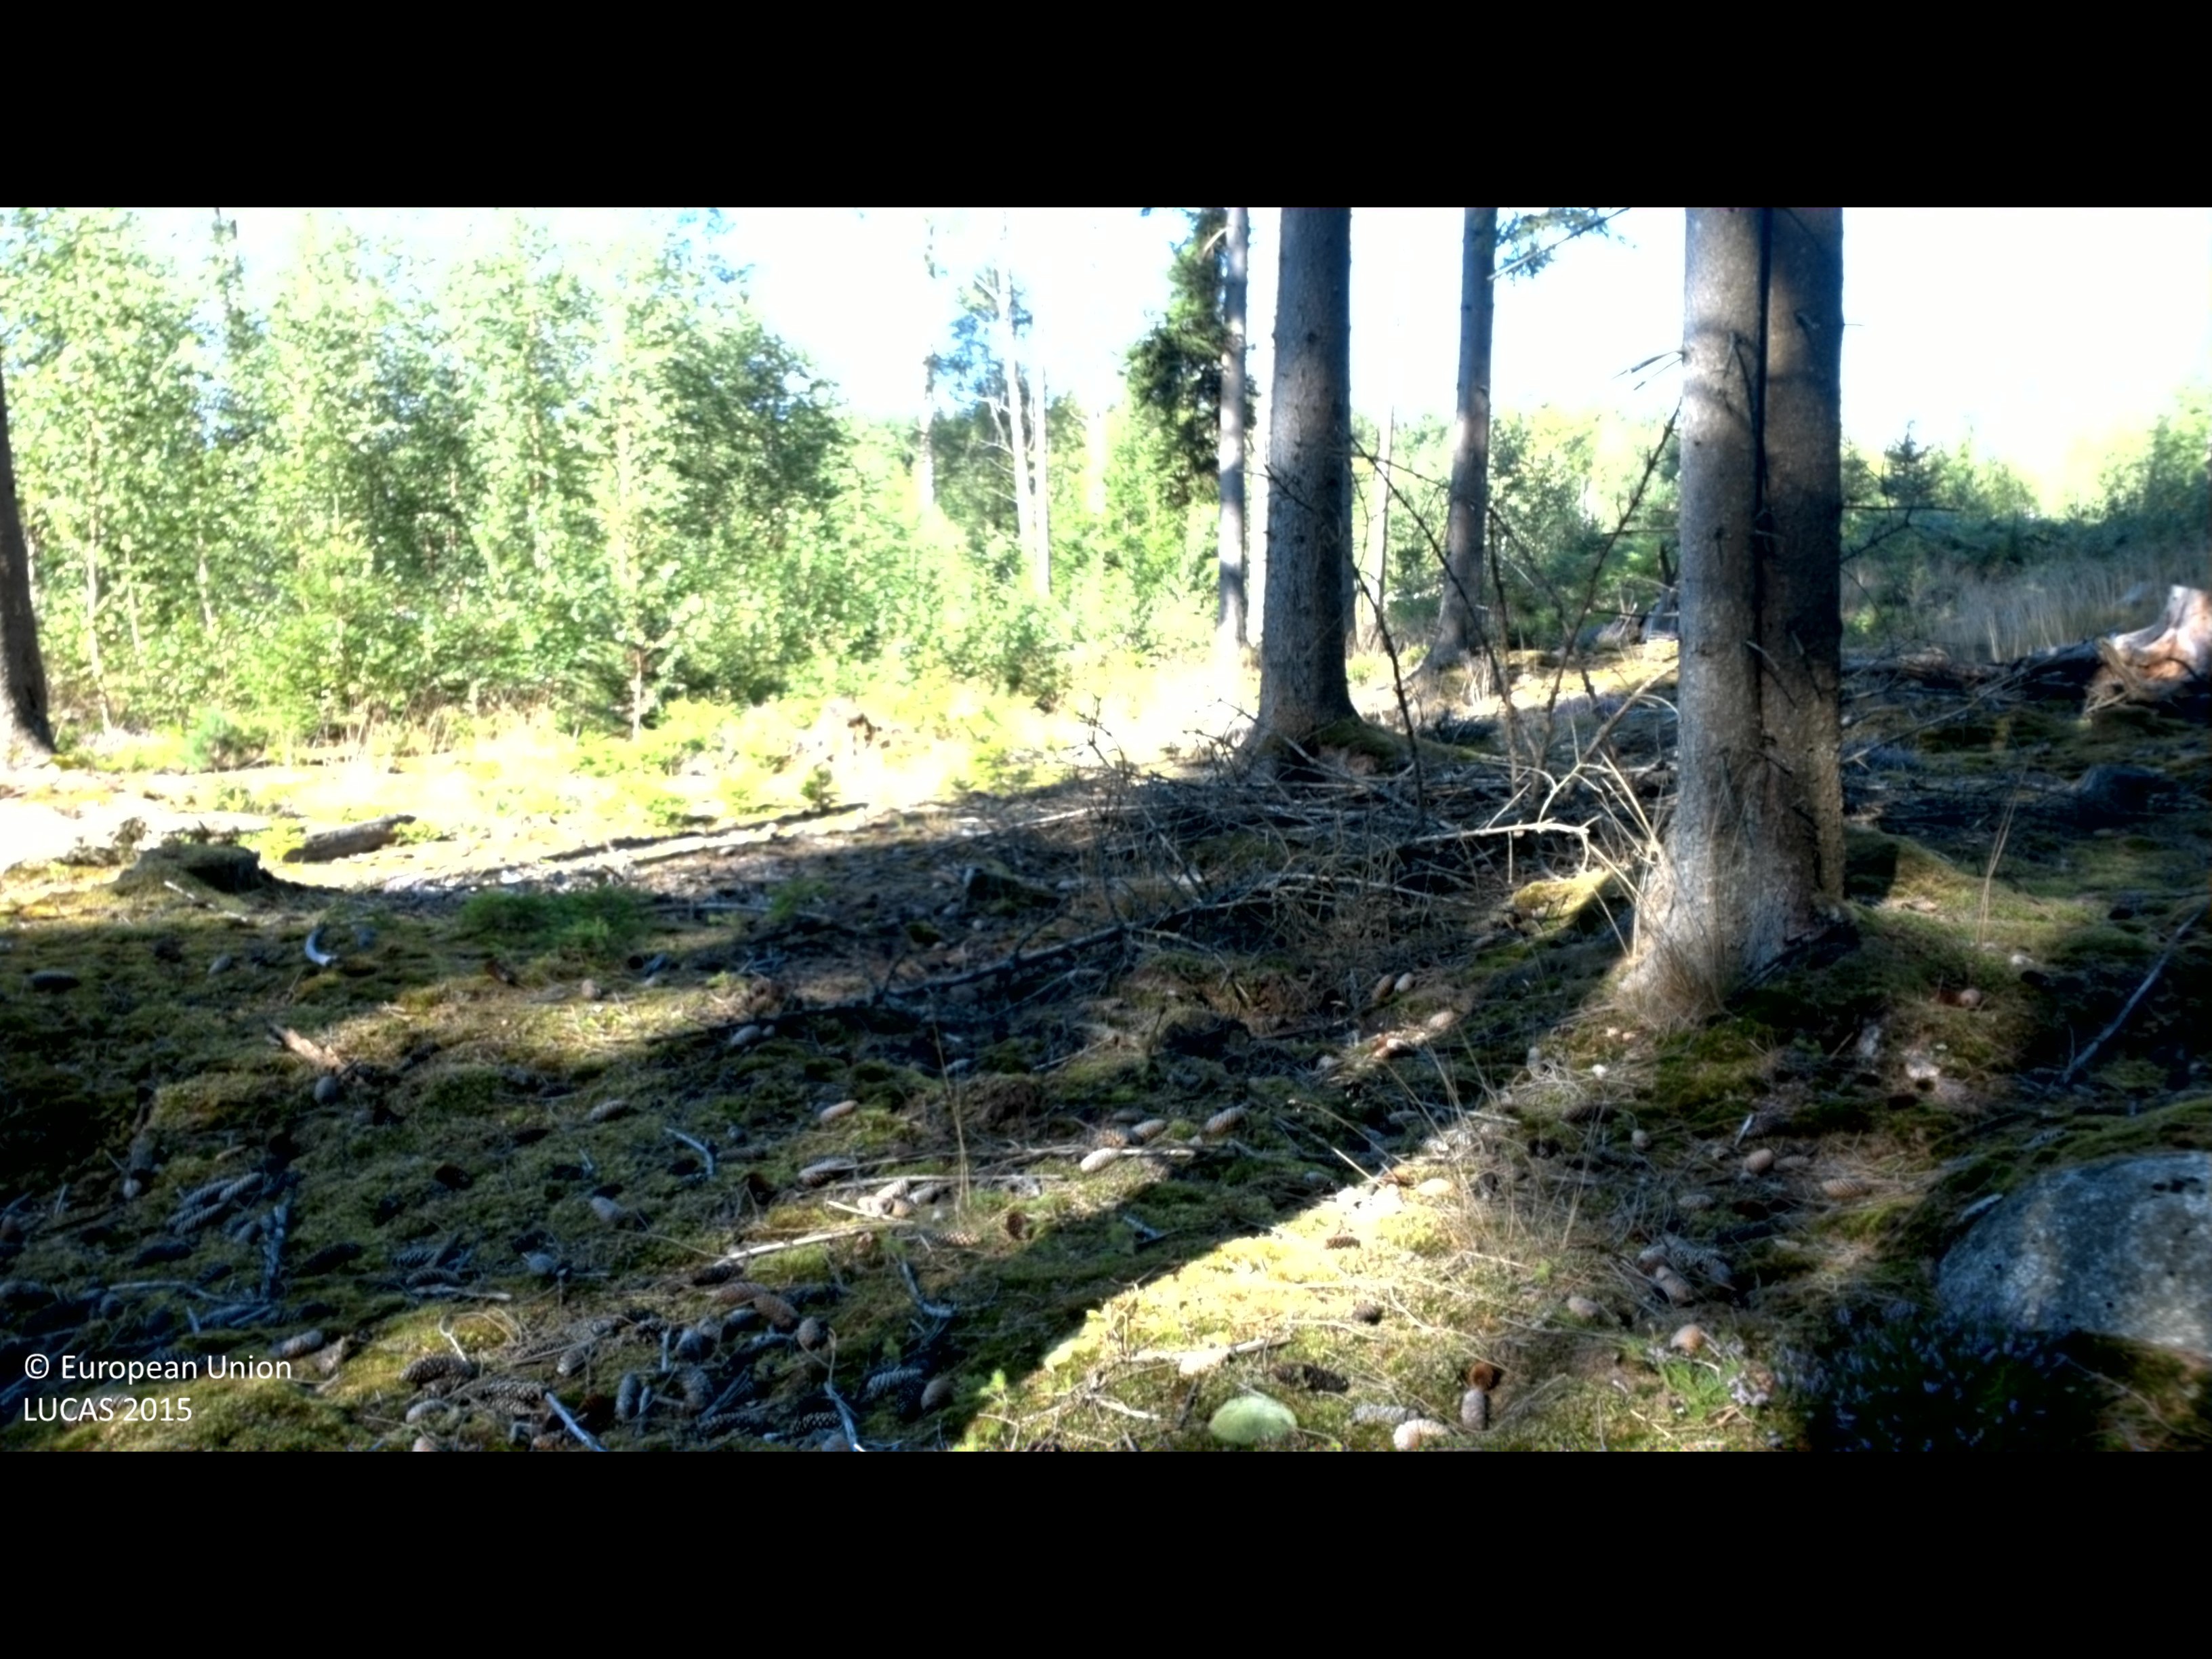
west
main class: Woodland
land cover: Spruce dominated coniferous woodland
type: boreal forest
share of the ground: 50 - 75 %
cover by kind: coniferous forest trees 65 %, lichens and mosses 30 %, consolidated bare surface 5 %
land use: Forestry
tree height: > 5 m
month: August
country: SE
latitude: 56.3033
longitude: 14.6040
